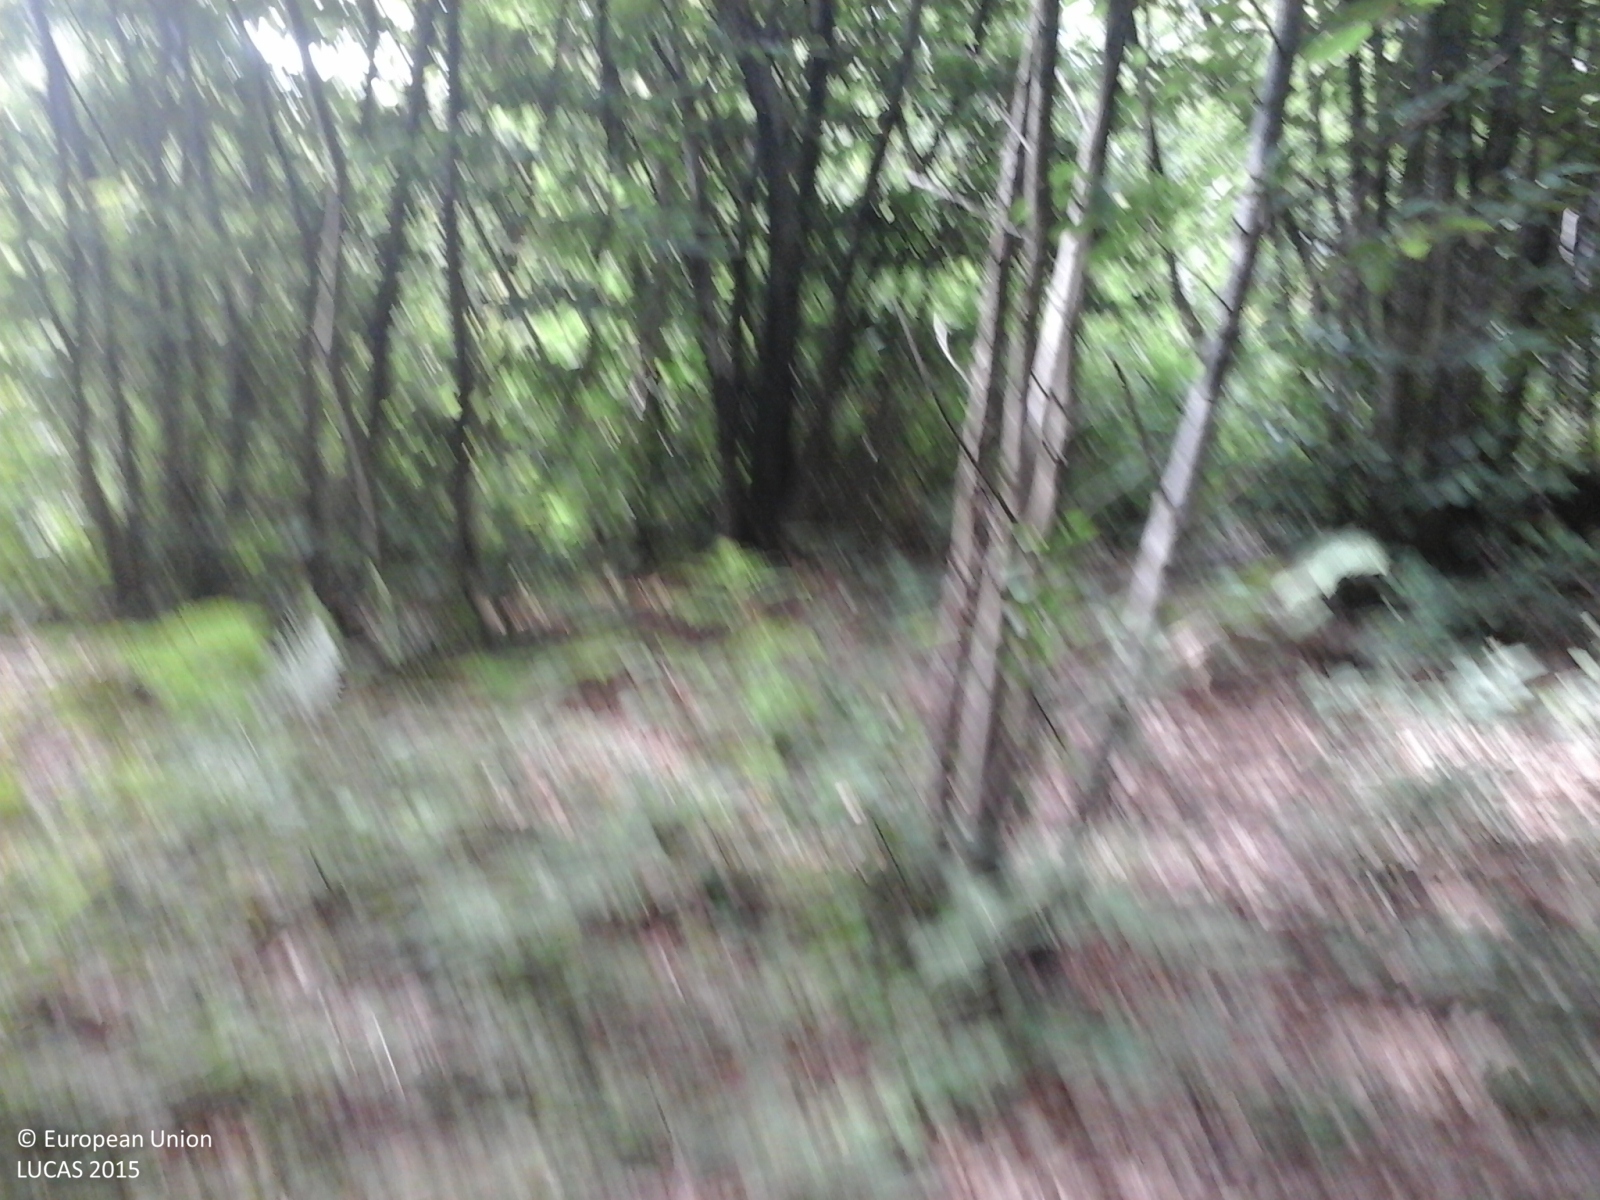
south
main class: Woodland
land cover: Broadleaved woodland
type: thermophilous deciduous forest
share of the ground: > 75 %
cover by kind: broadleaved forest trees 100 %
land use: Forestry
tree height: > 5 m
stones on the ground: < 10 %
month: June
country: IT
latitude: 45.4849
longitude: 7.9690
